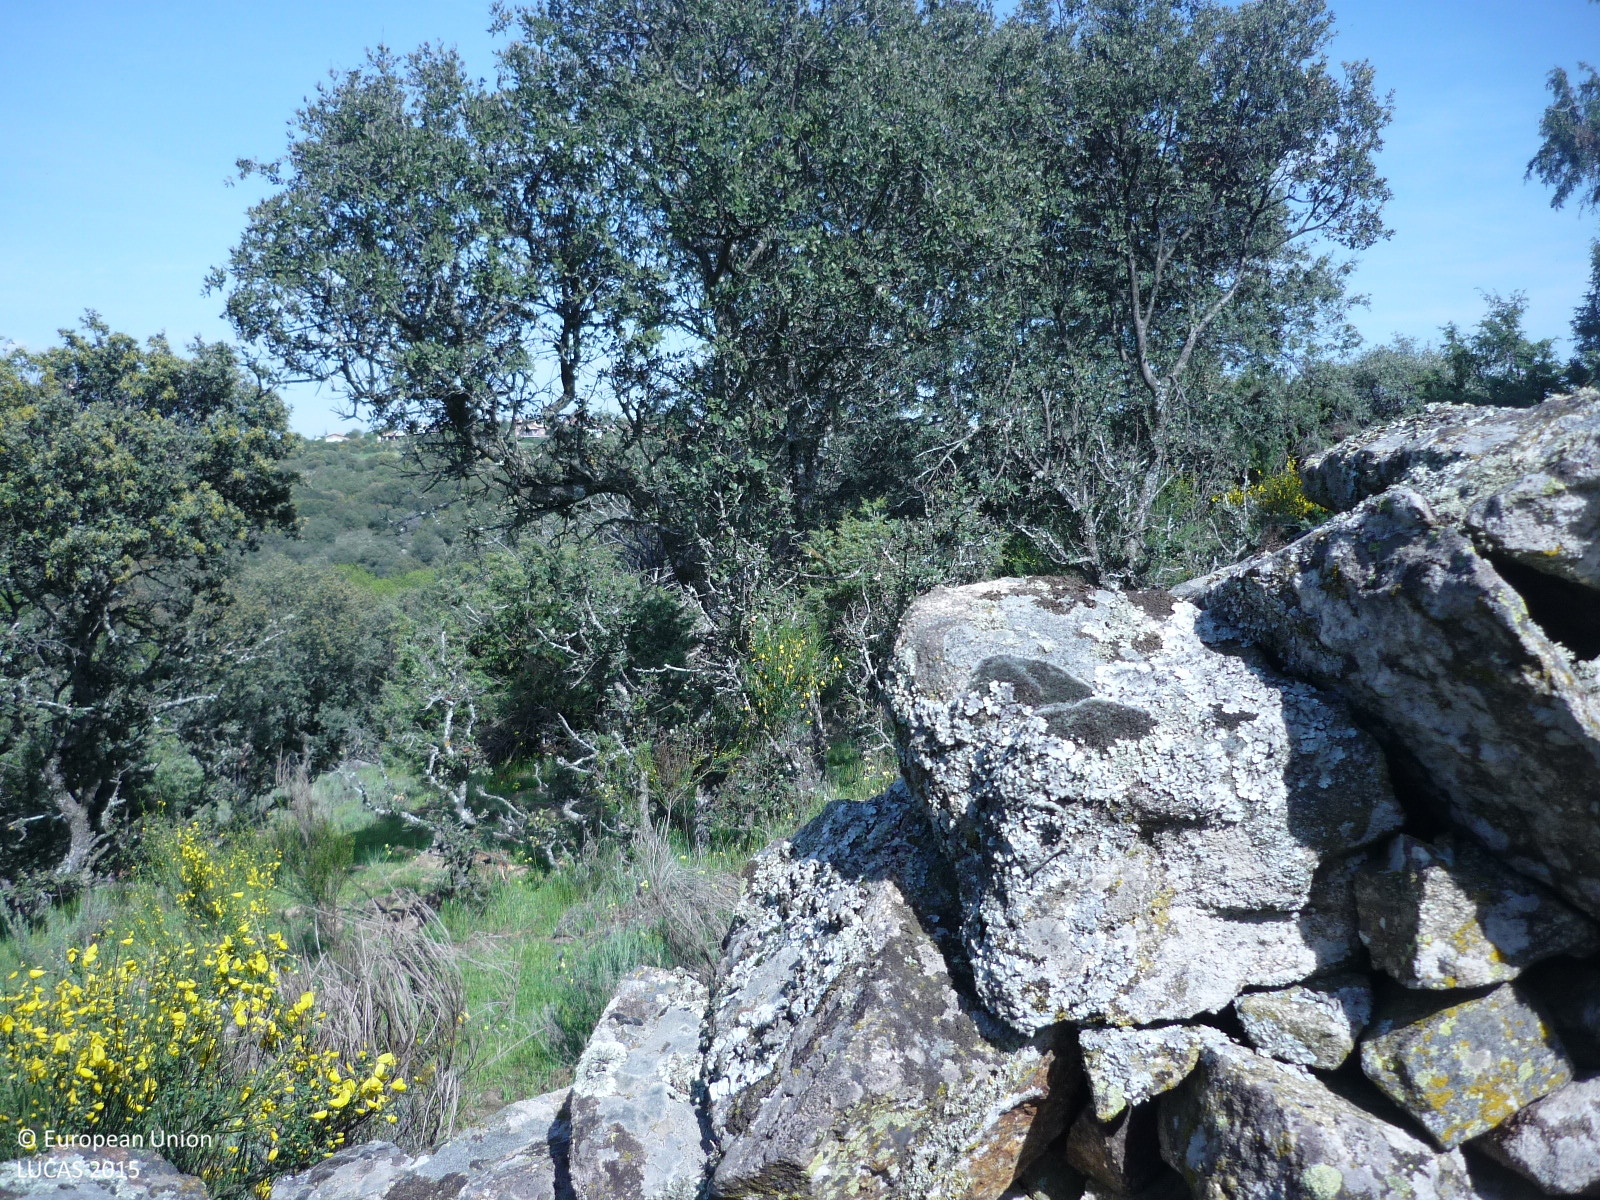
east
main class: Woodland
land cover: Broadleaved woodland
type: broadleaved evergreen forest
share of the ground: 50 - 75 %
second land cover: Grassland without tree/shrub cover
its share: > 75 %
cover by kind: broadleaved forest trees 60 %, herbaceous plants 30 %, shrubs 10 %
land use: Forestry
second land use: Agriculture (excluding fallow land and kitchen gardens)
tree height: > 5 m
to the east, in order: Broadleaved woodland; Grassland without tree/shrub cover; Dry stone walls; Broadleaved woodland; Grassland with sparse tree/shrub cover; Dry stone walls; Tracks; Broadleaved woodland
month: April
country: ES
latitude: 40.7374
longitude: -3.6469
